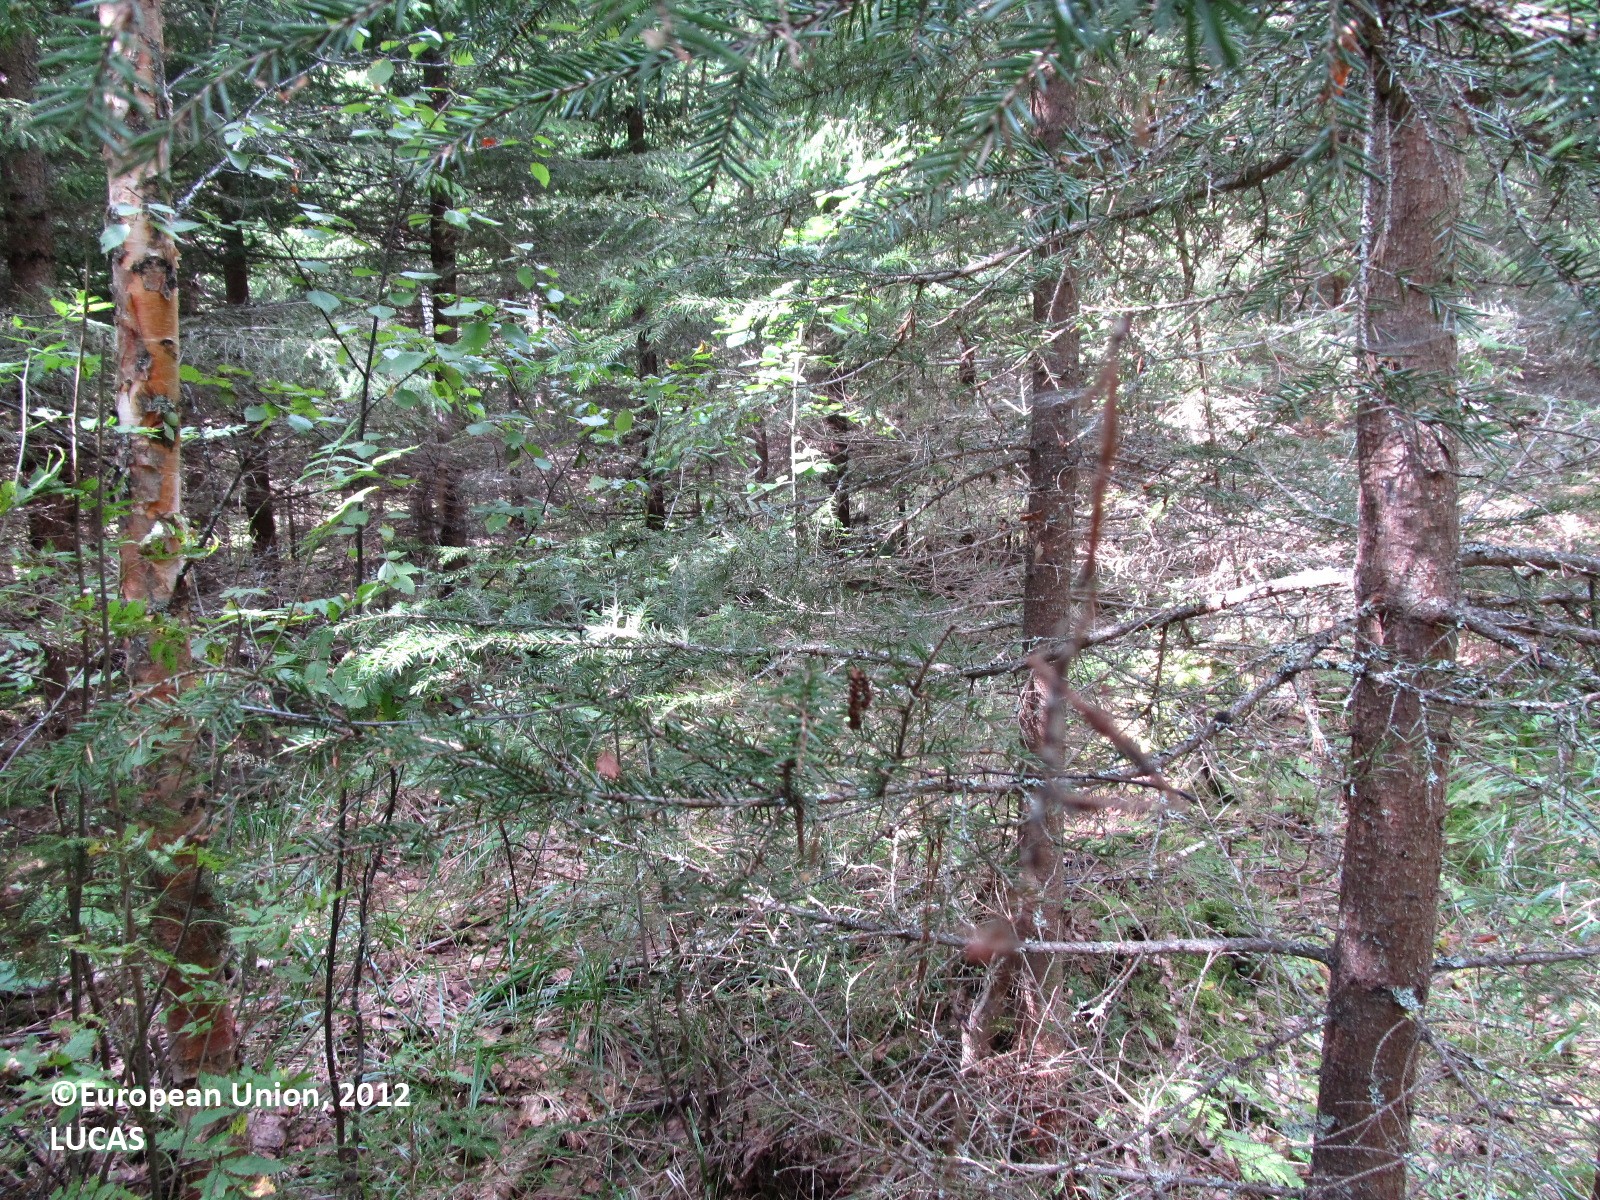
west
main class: Woodland
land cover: Spruce dominated coniferous woodland
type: boreal forest
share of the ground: 50 - 75 %
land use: Forestry
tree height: > 5 m
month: August
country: FI
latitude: 62.2183
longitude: 28.4534
